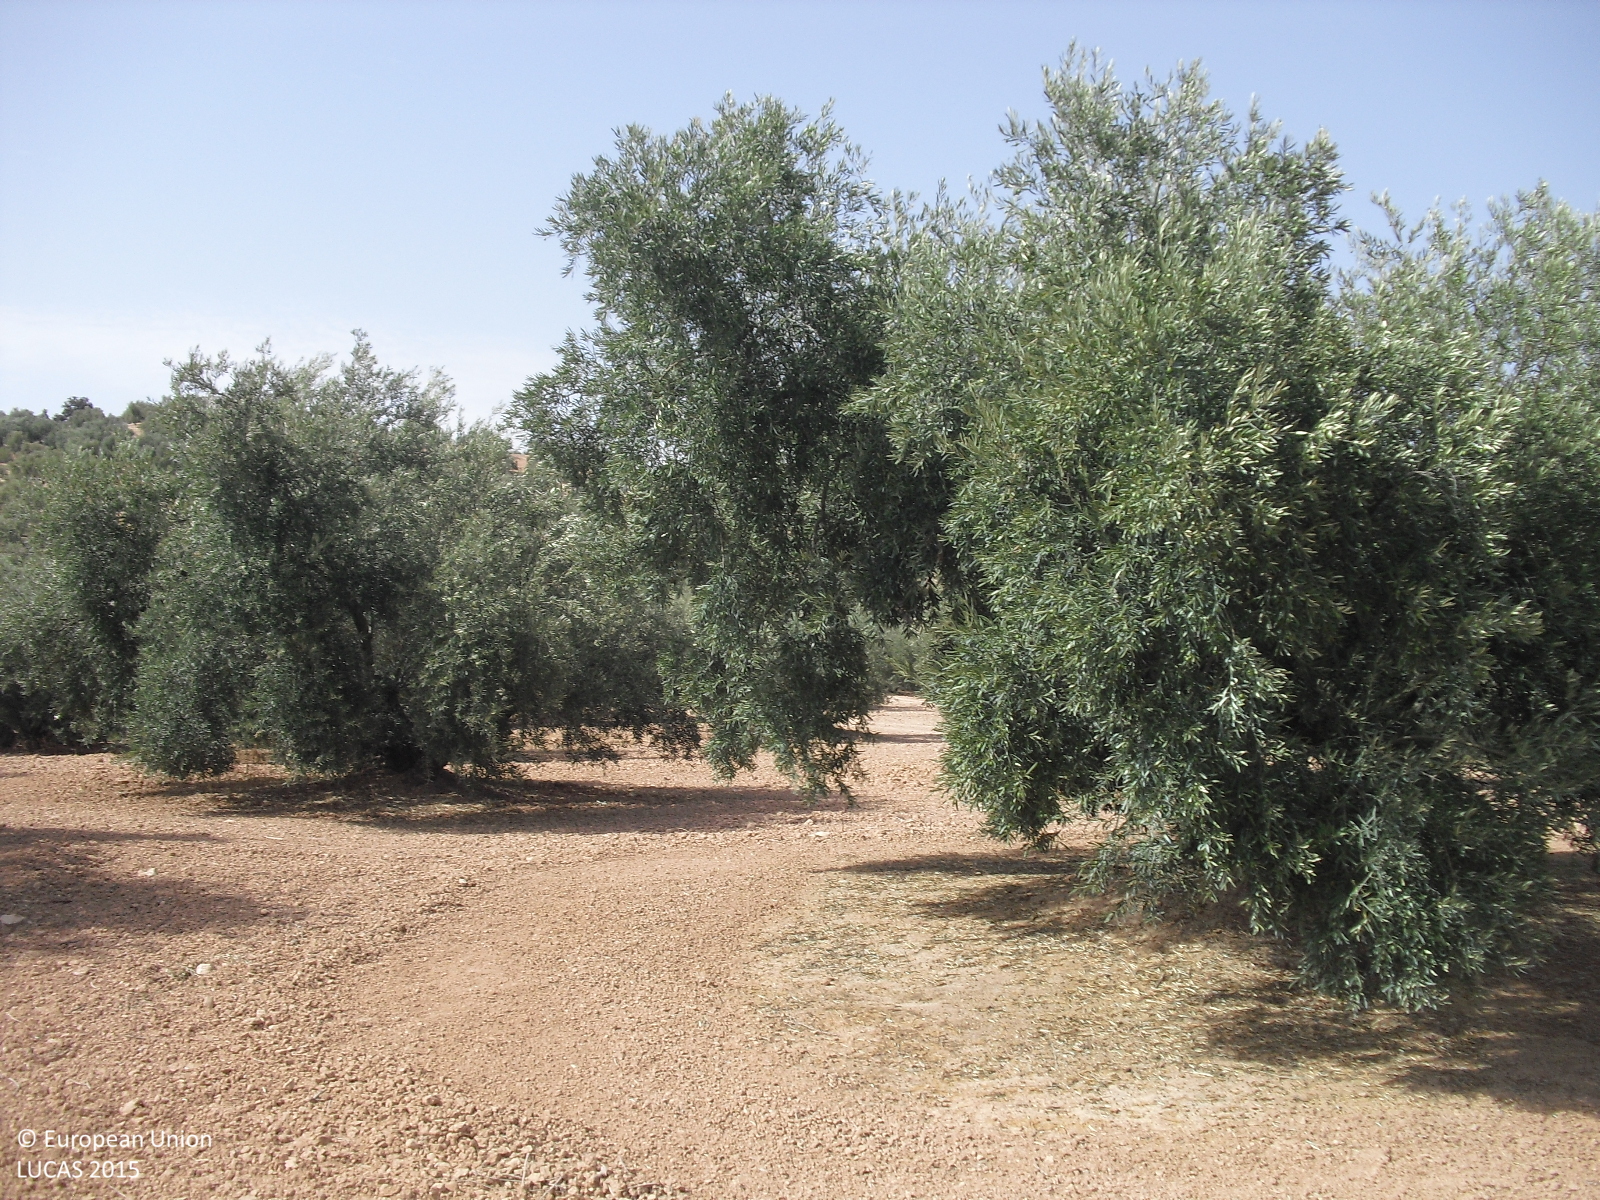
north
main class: Cropland
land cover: Olive groves
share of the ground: 25 - 50 %
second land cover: Other bare soil
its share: > 75 %
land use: Agriculture (excluding fallow land and kitchen gardens)
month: August
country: ES
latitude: 37.2917
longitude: -4.3817
